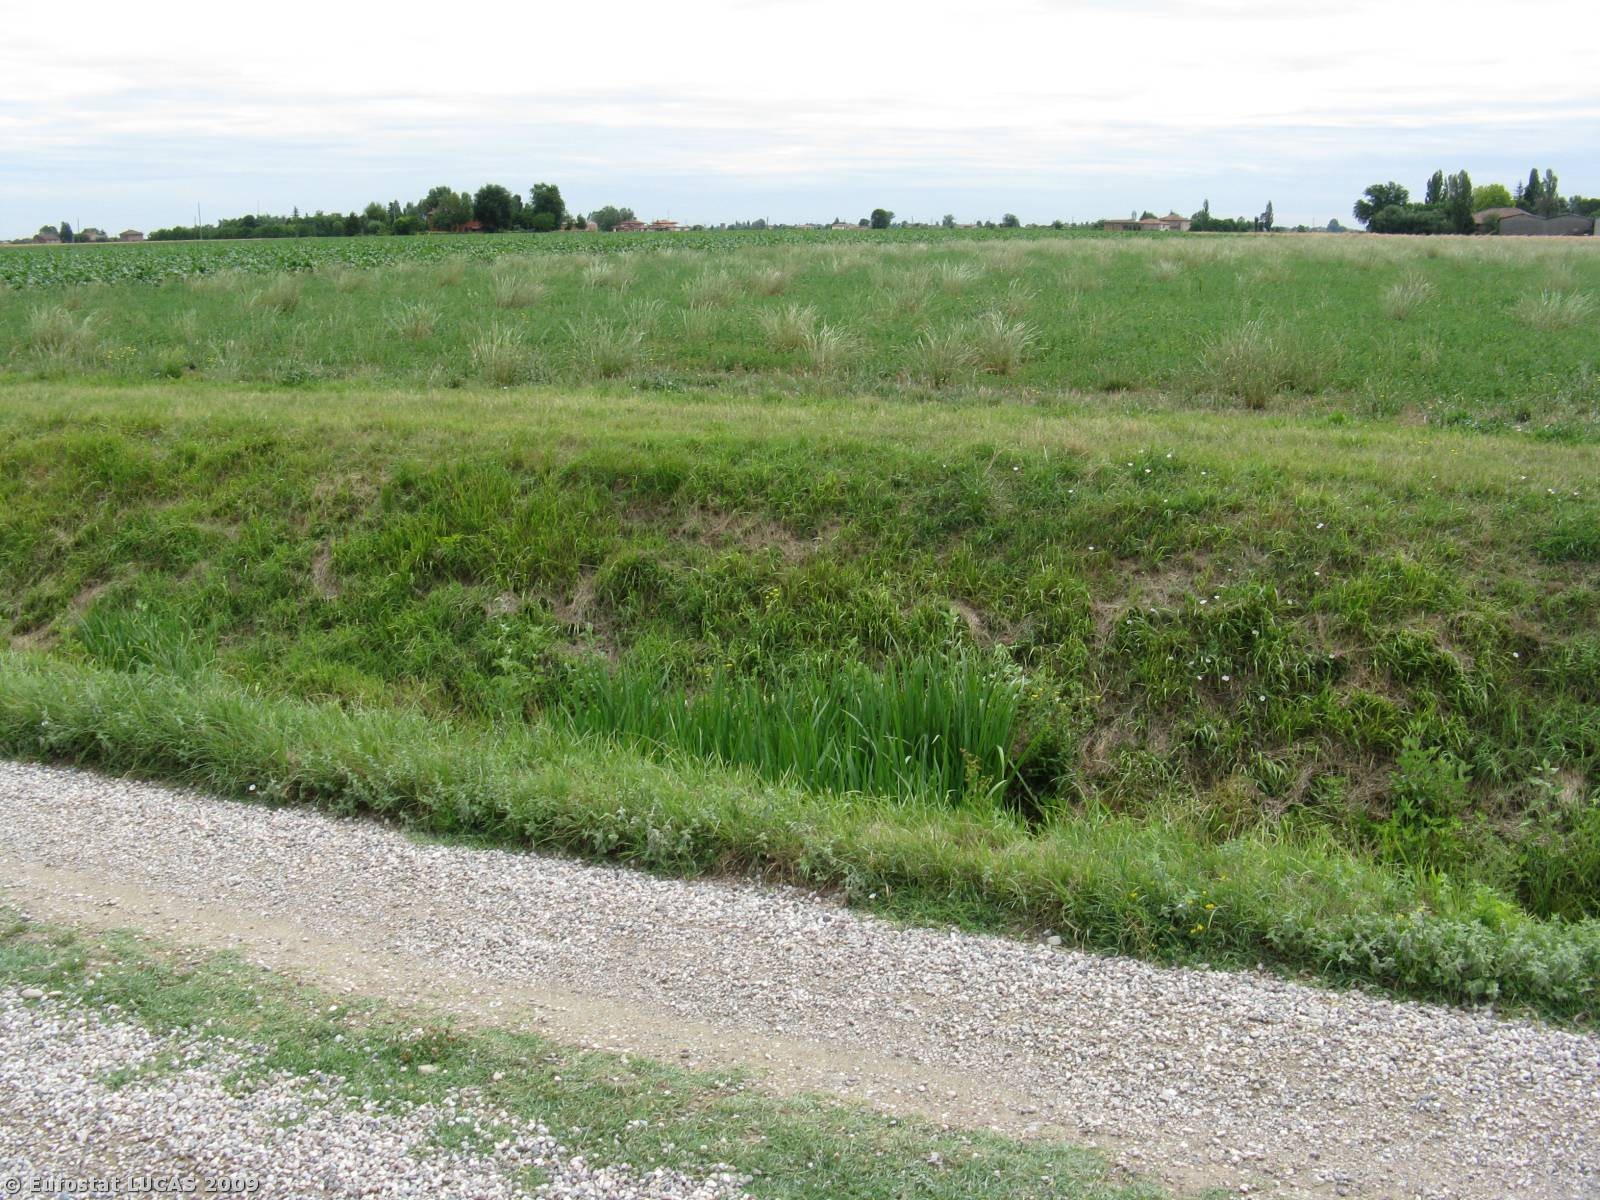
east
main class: Cropland
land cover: Durum wheat
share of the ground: > 75 %
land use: Agriculture (excluding fallow land and kitchen gardens)
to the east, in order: Durum wheat; Electric lines; Ditches and canals; Paved roads, cycling and walking lanes; Grass margins; Ditches and canals; Tracks; Lucerne; Ditches and canals; Sugar beet; Ditches and canals; Sugar beet
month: June
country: IT
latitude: 44.4638
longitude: 11.6430
